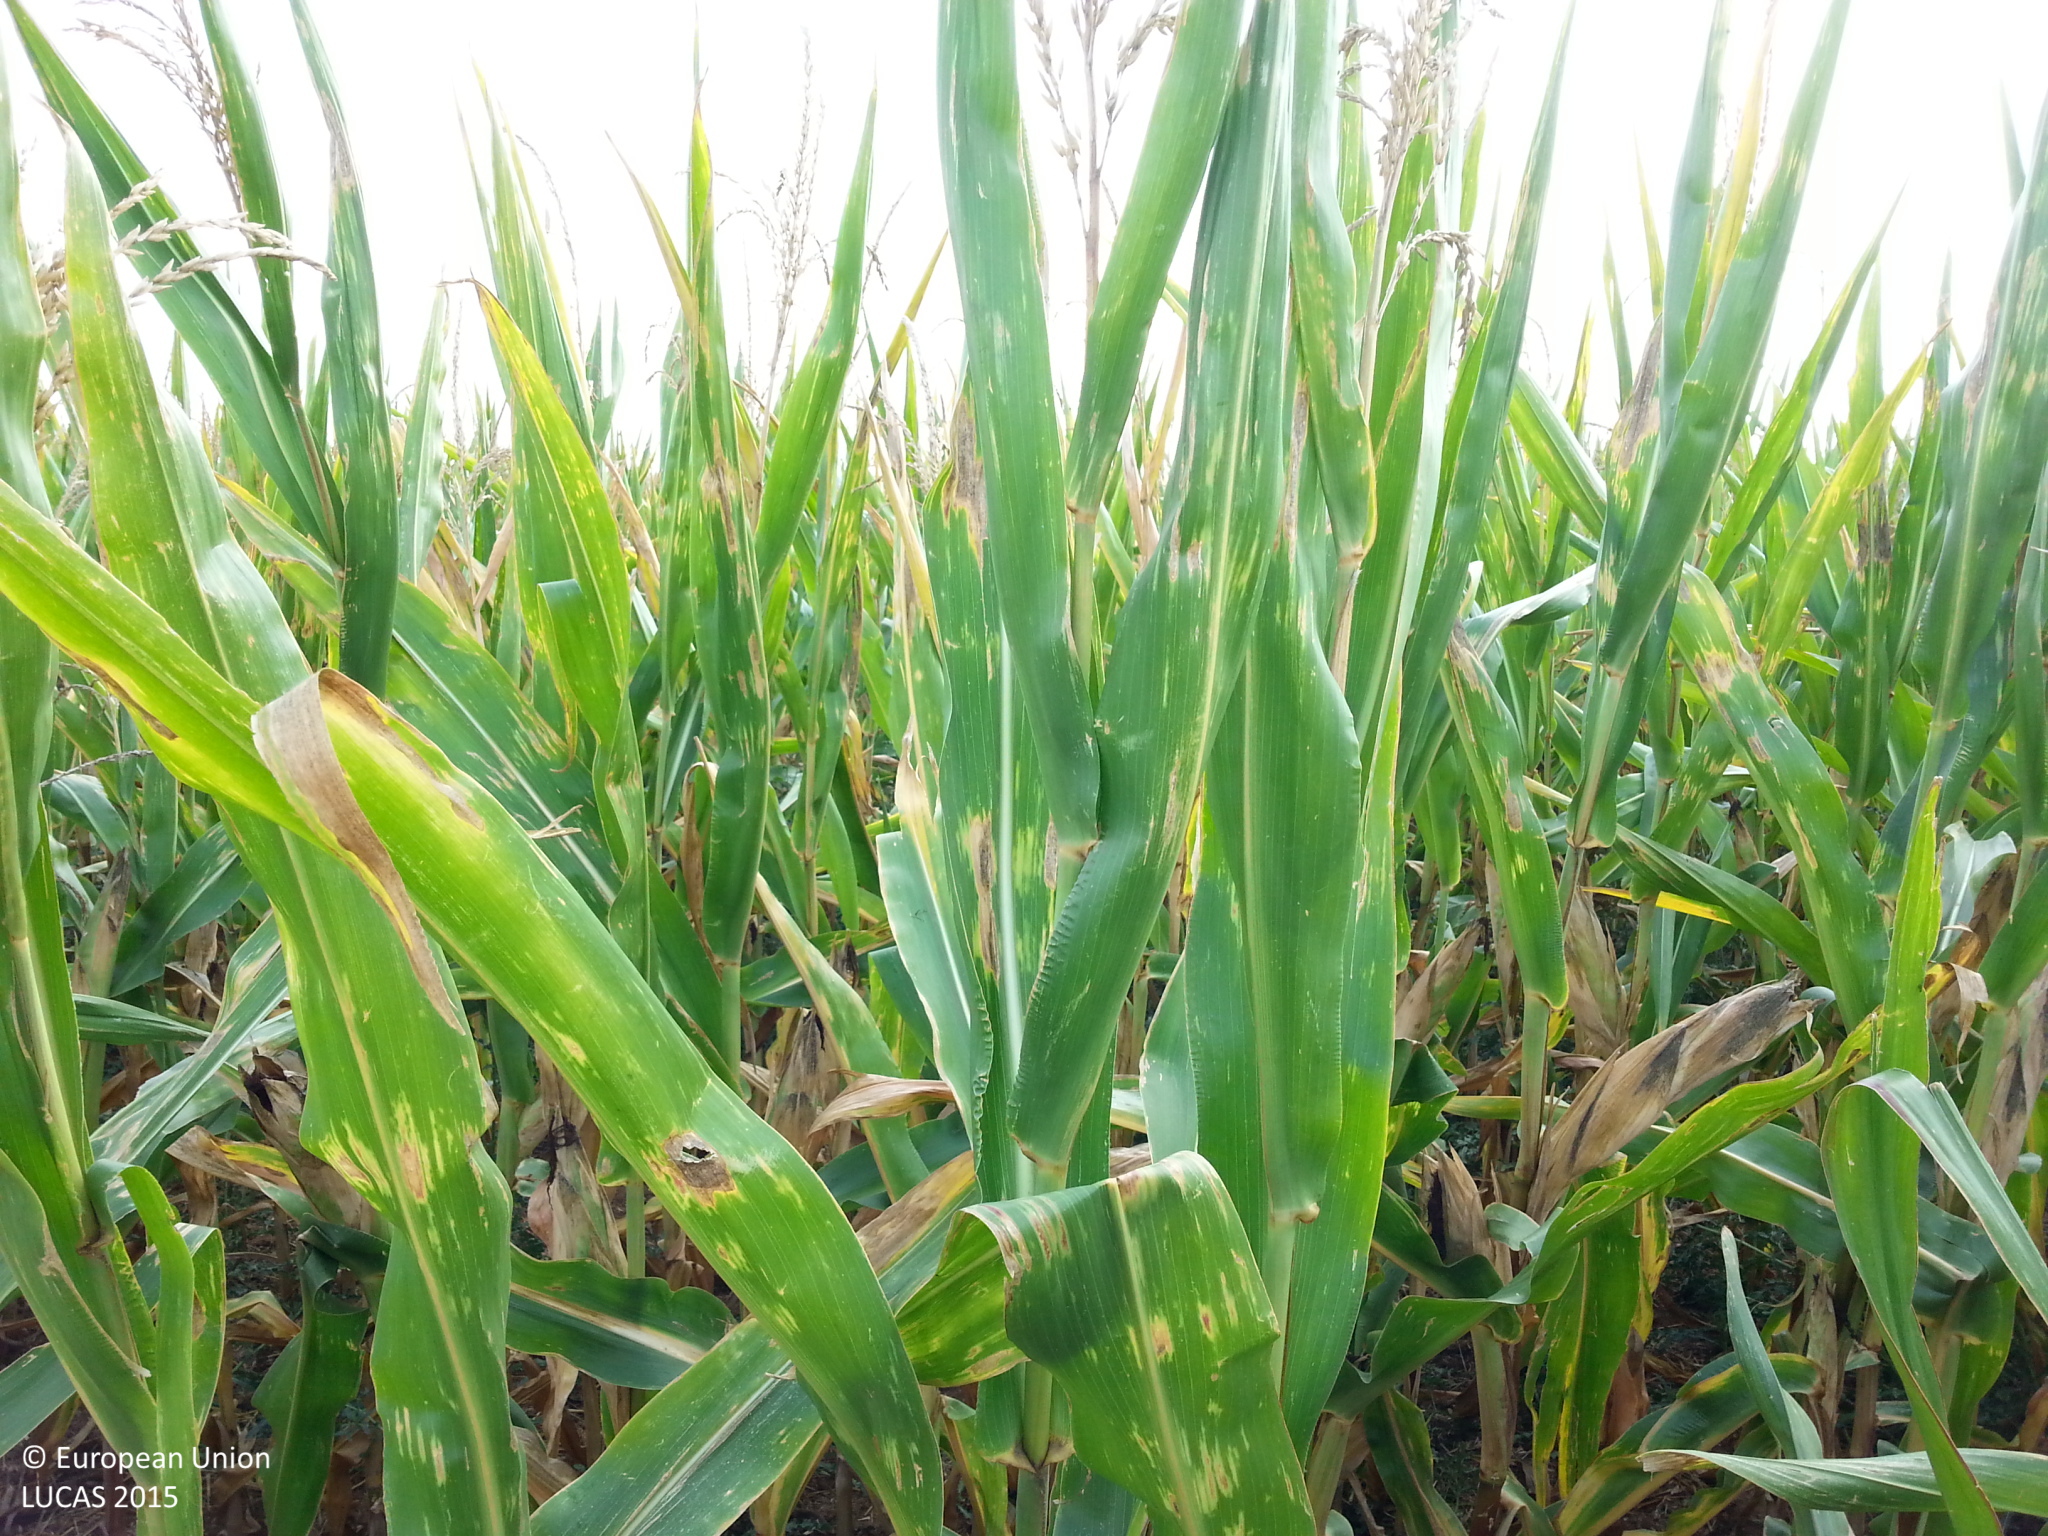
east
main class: Cropland
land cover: Maize
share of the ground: > 75 %
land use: Agriculture (excluding fallow land and kitchen gardens)
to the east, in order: Maize; Grassland without tree/shrub cover; Maize; Grass margins; Tracks; Grass margins; Ditches and canals; Grass margins; Abandoned hedges; Grass margins; Rape and turnip rape
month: September
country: DE
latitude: 49.3569
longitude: 9.9587
